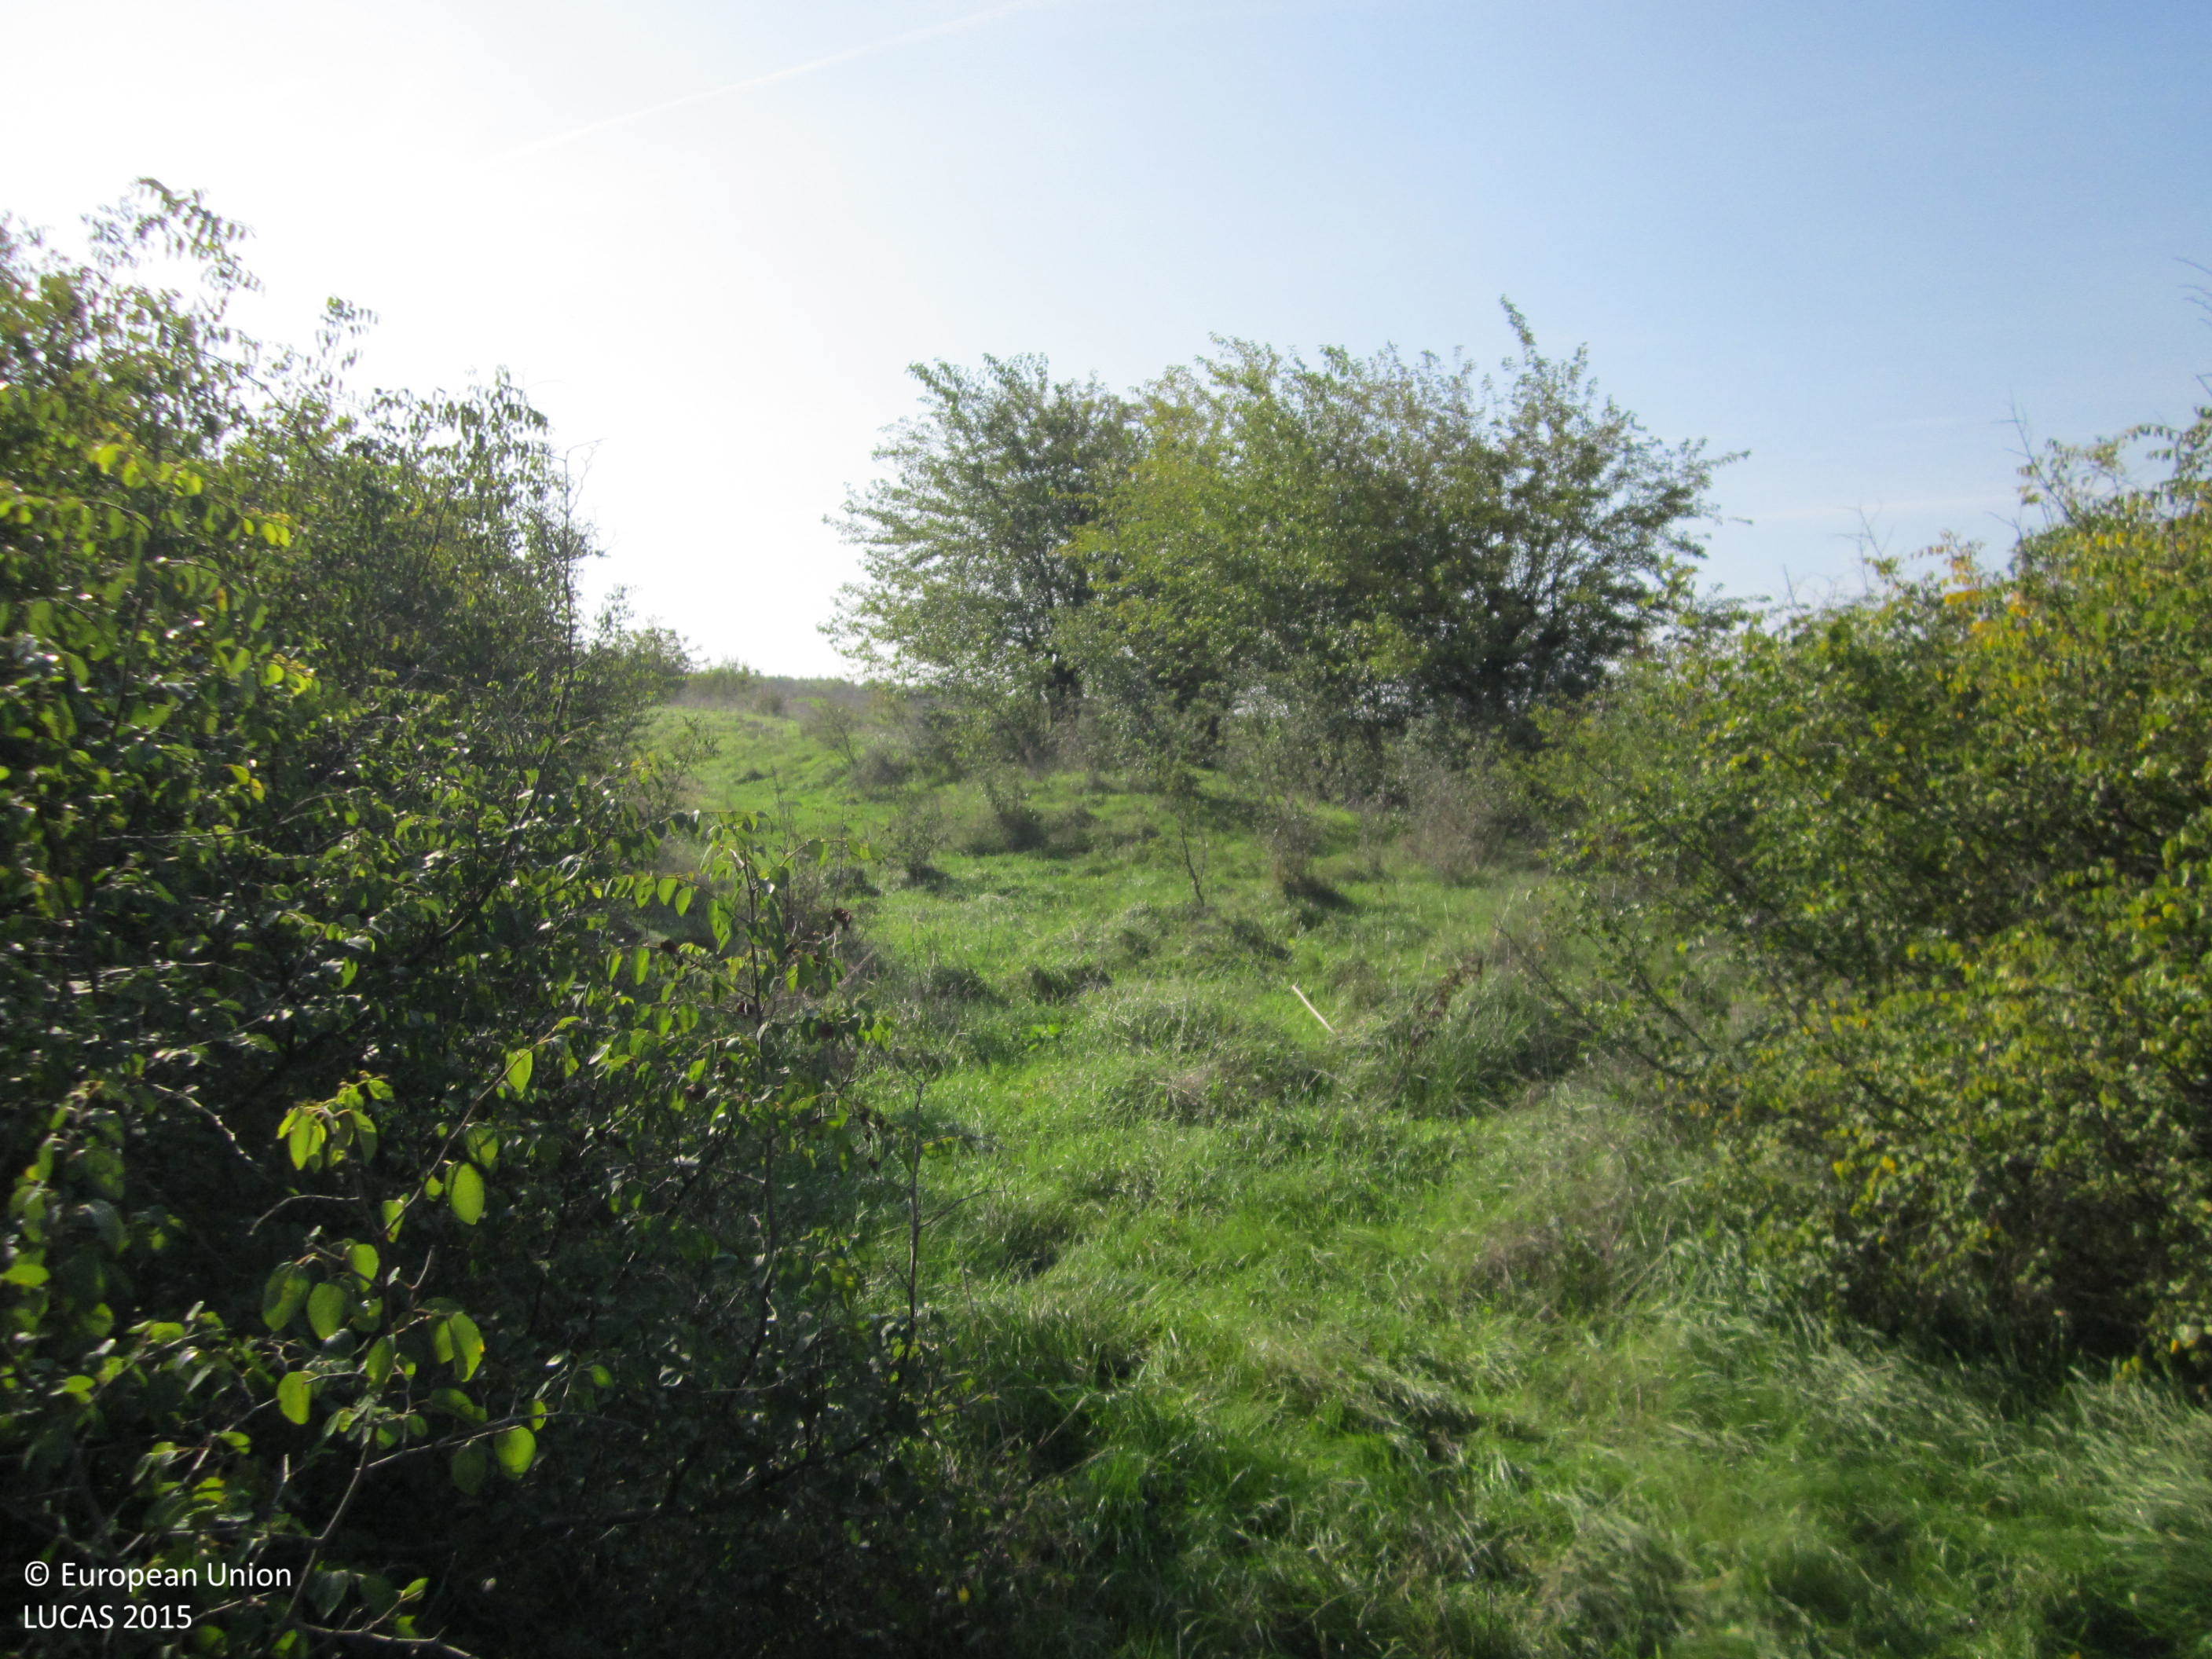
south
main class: Shrubland
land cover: Shrubland without tree cover
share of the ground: 25 - 50 %
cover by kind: herbaceous plants 55 %, shrubs 45 %
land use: Semi-natural and natural areas not in use
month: October
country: BG
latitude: 42.6829
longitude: 26.8598
